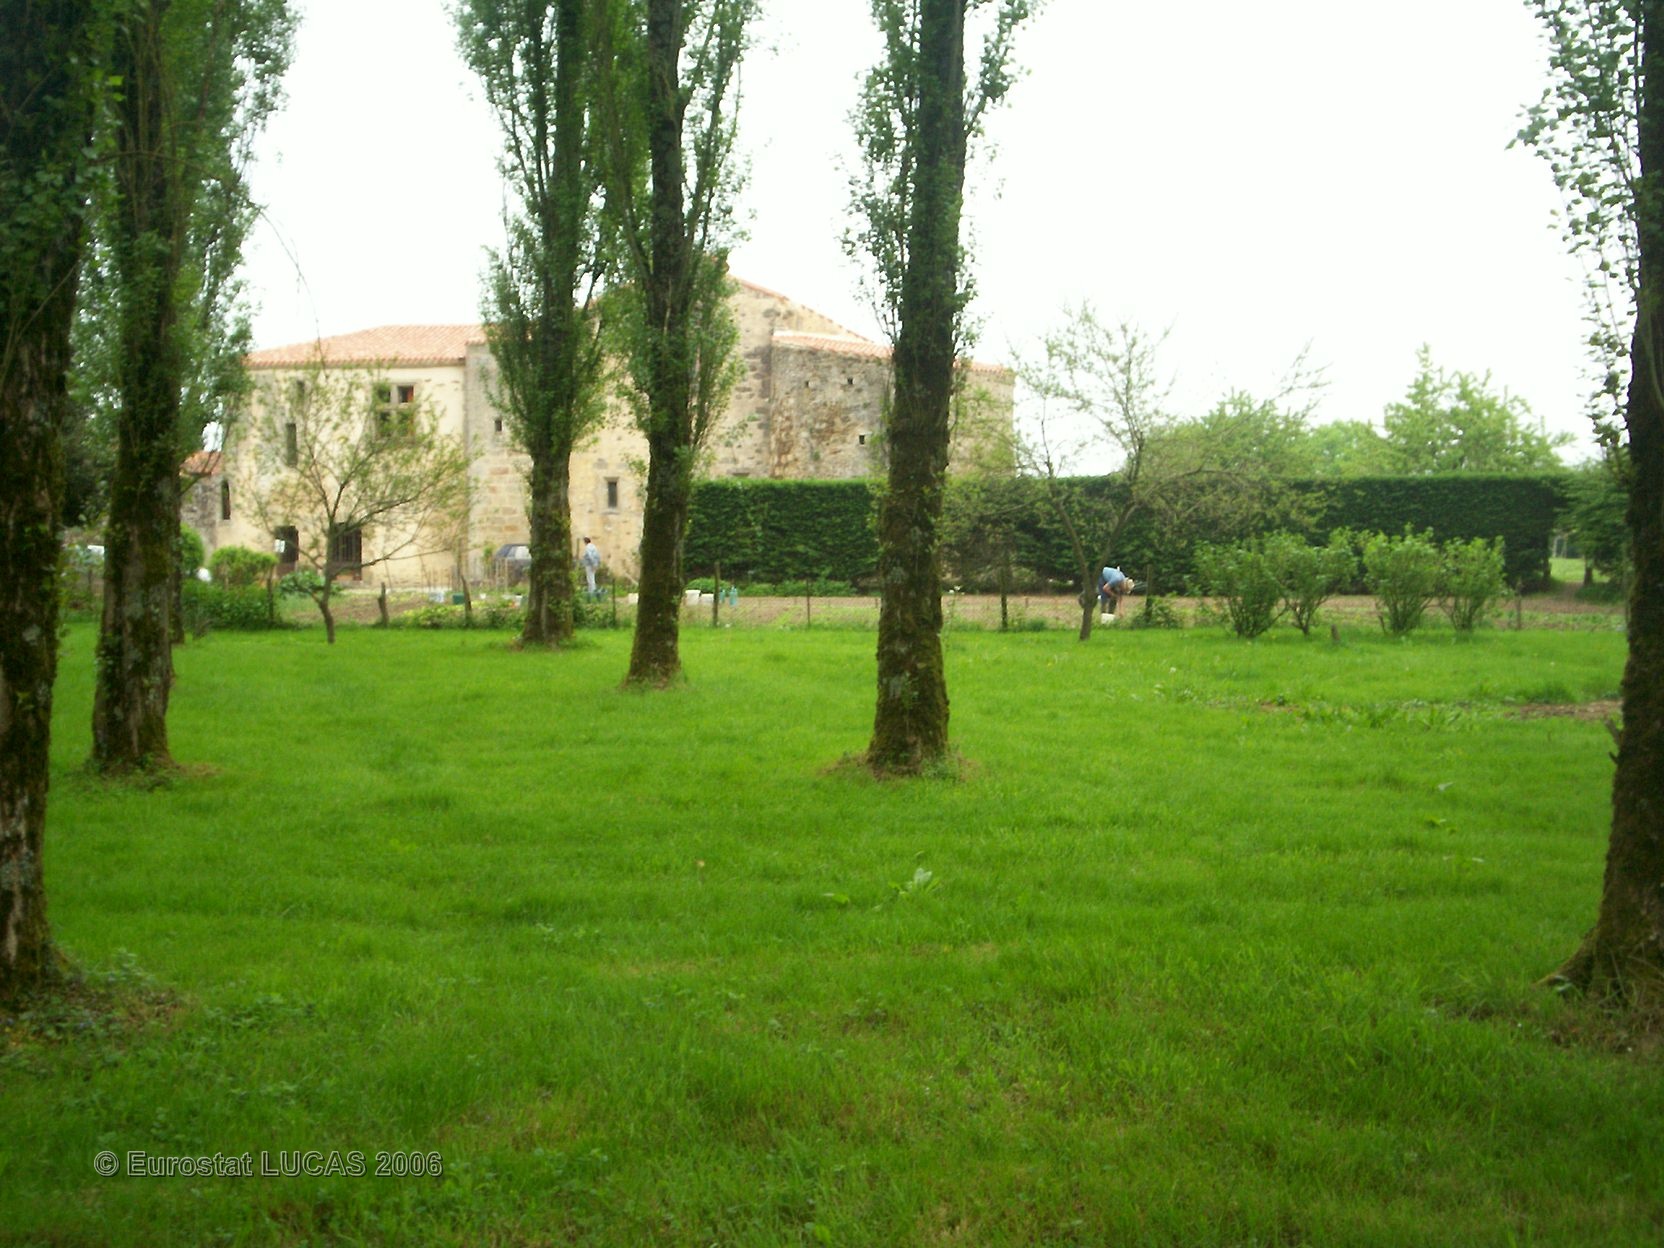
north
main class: Grassland
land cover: Grassland with sparse tree/shrub cover
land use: Amenities, museums, leisure
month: May
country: FR
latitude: 46.8297
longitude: -1.0594
